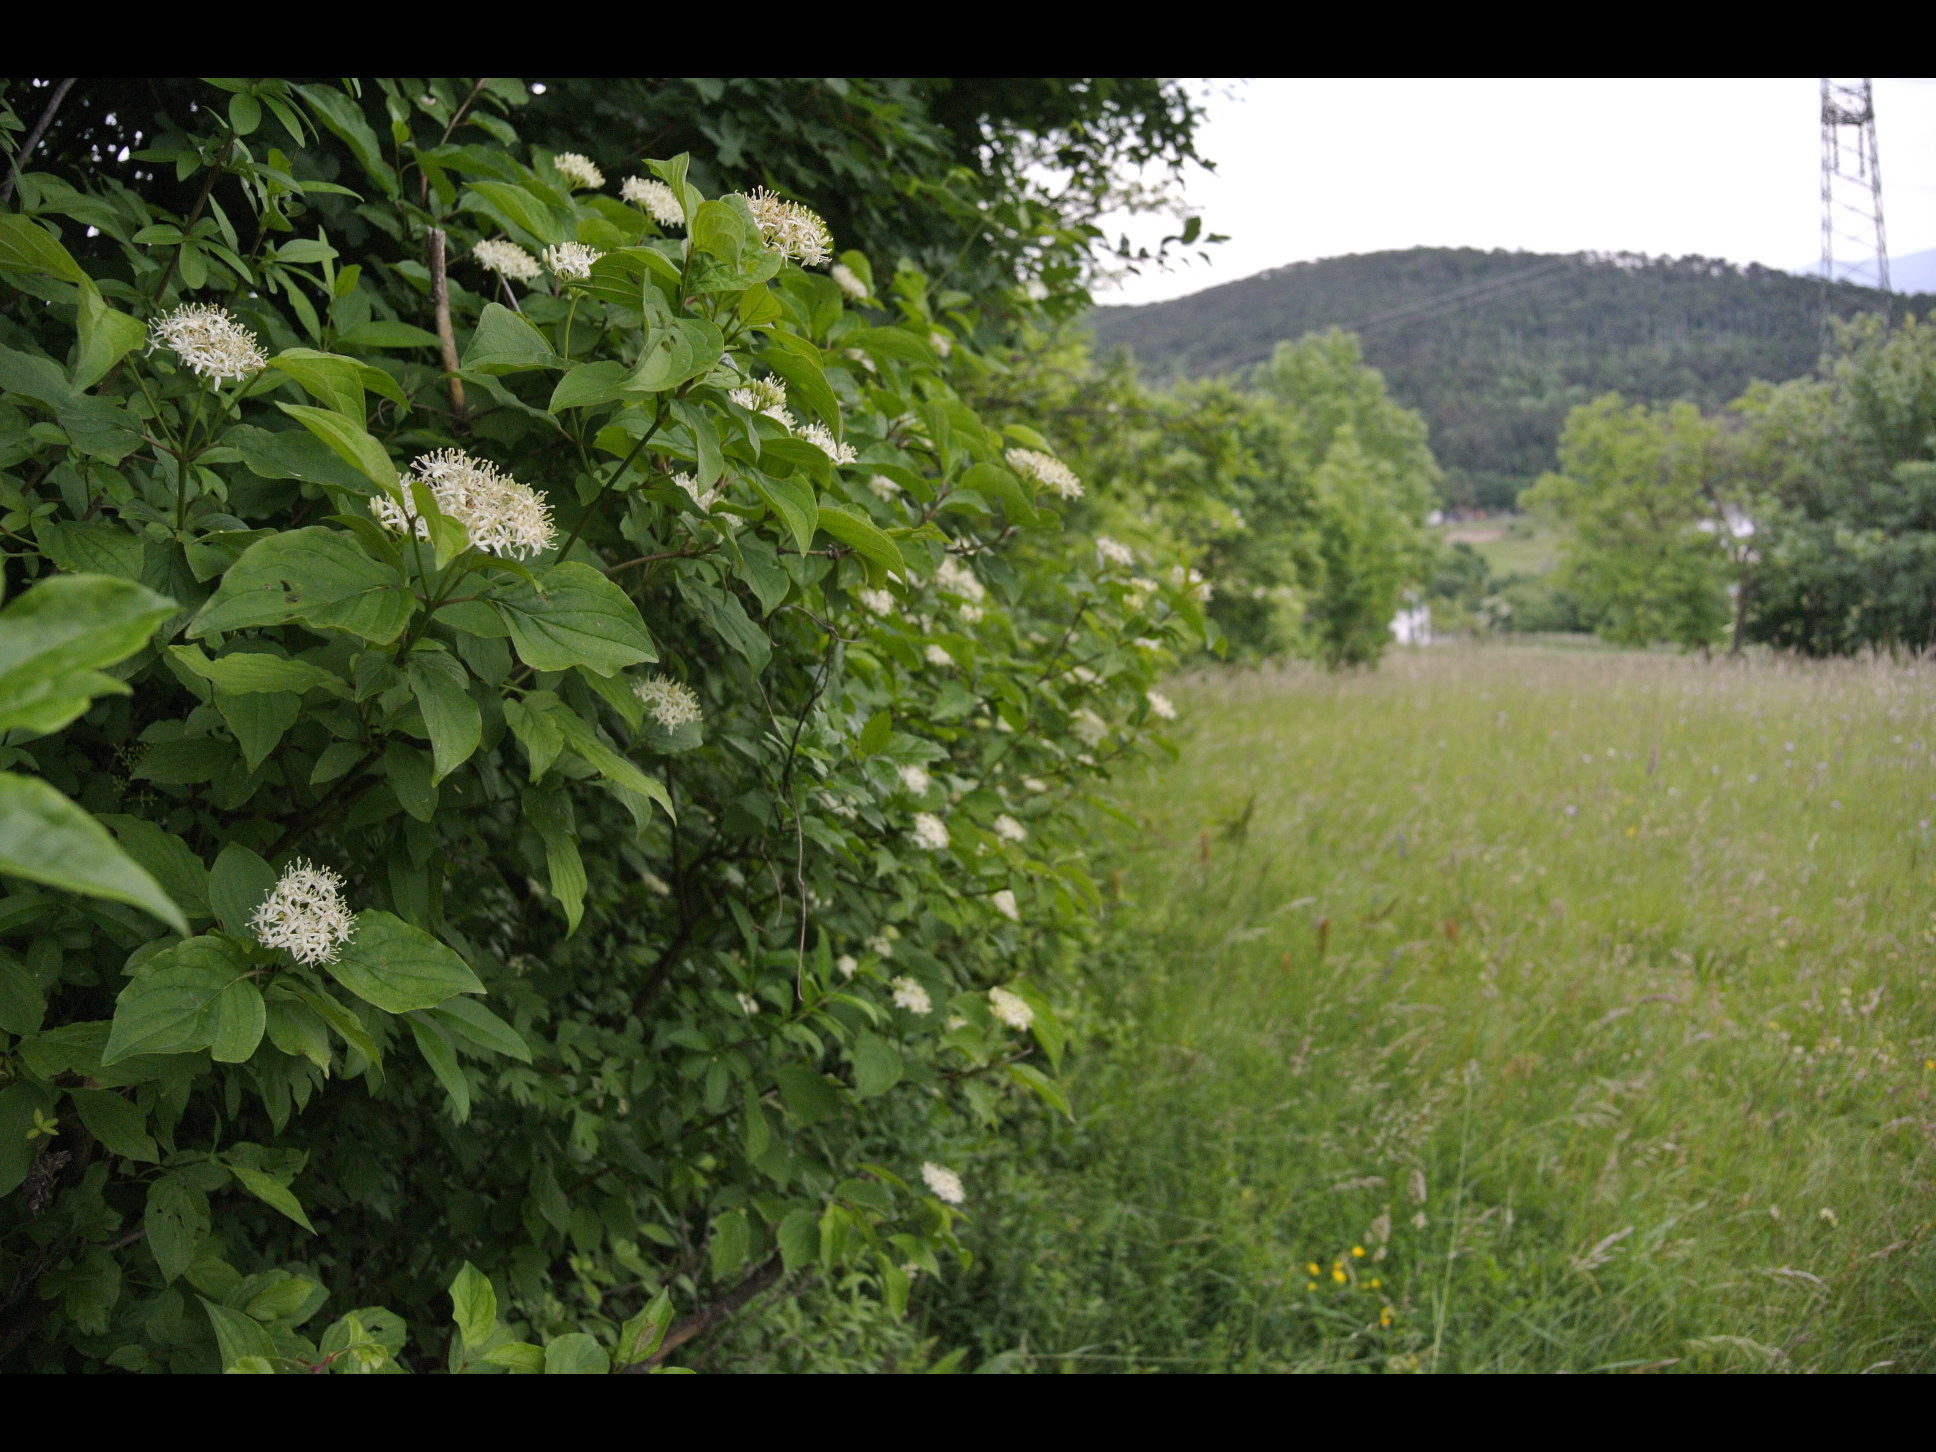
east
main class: Woodland
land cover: Broadleaved woodland
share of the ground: > 75 %
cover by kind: broadleaved forest trees 100 %
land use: Semi-natural and natural areas not in use
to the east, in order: Broadleaved woodland; Grassland without tree/shrub cover; Tracks; Grassland without tree/shrub cover; Broadleaved woodland; Fences; Paved roads, cycling and walking lanes; Other coniferous woodland; Grassland without tree/shrub cover; Electric lines; Grassland without tree/shrub cover; Common wheat; Grassland without tree/shrub cover
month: May
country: AT
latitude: 47.8032
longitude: 16.0783
